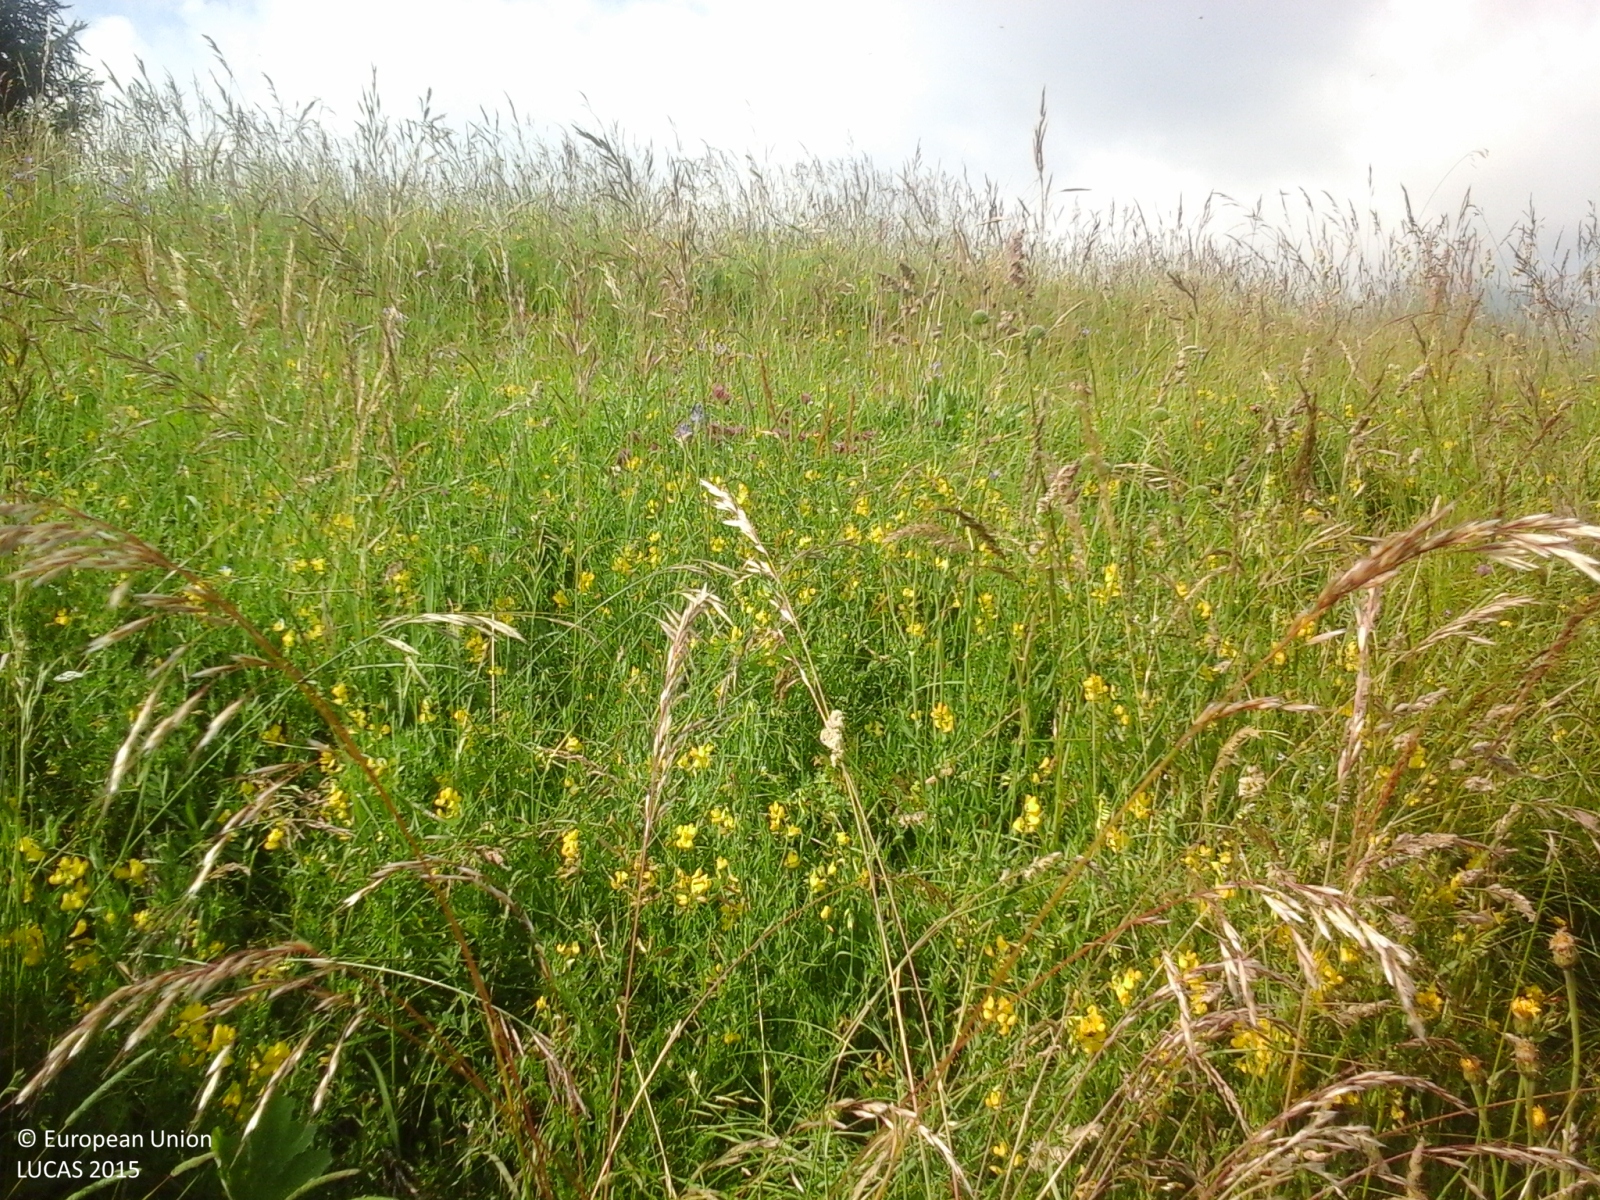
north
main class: Grassland
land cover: Grassland without tree/shrub cover
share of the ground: > 75 %
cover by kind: herbaceous plants 100 %
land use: Agriculture (excluding fallow land and kitchen gardens)
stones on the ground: < 10 %
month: July
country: IT
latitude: 45.7509
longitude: 7.7536
